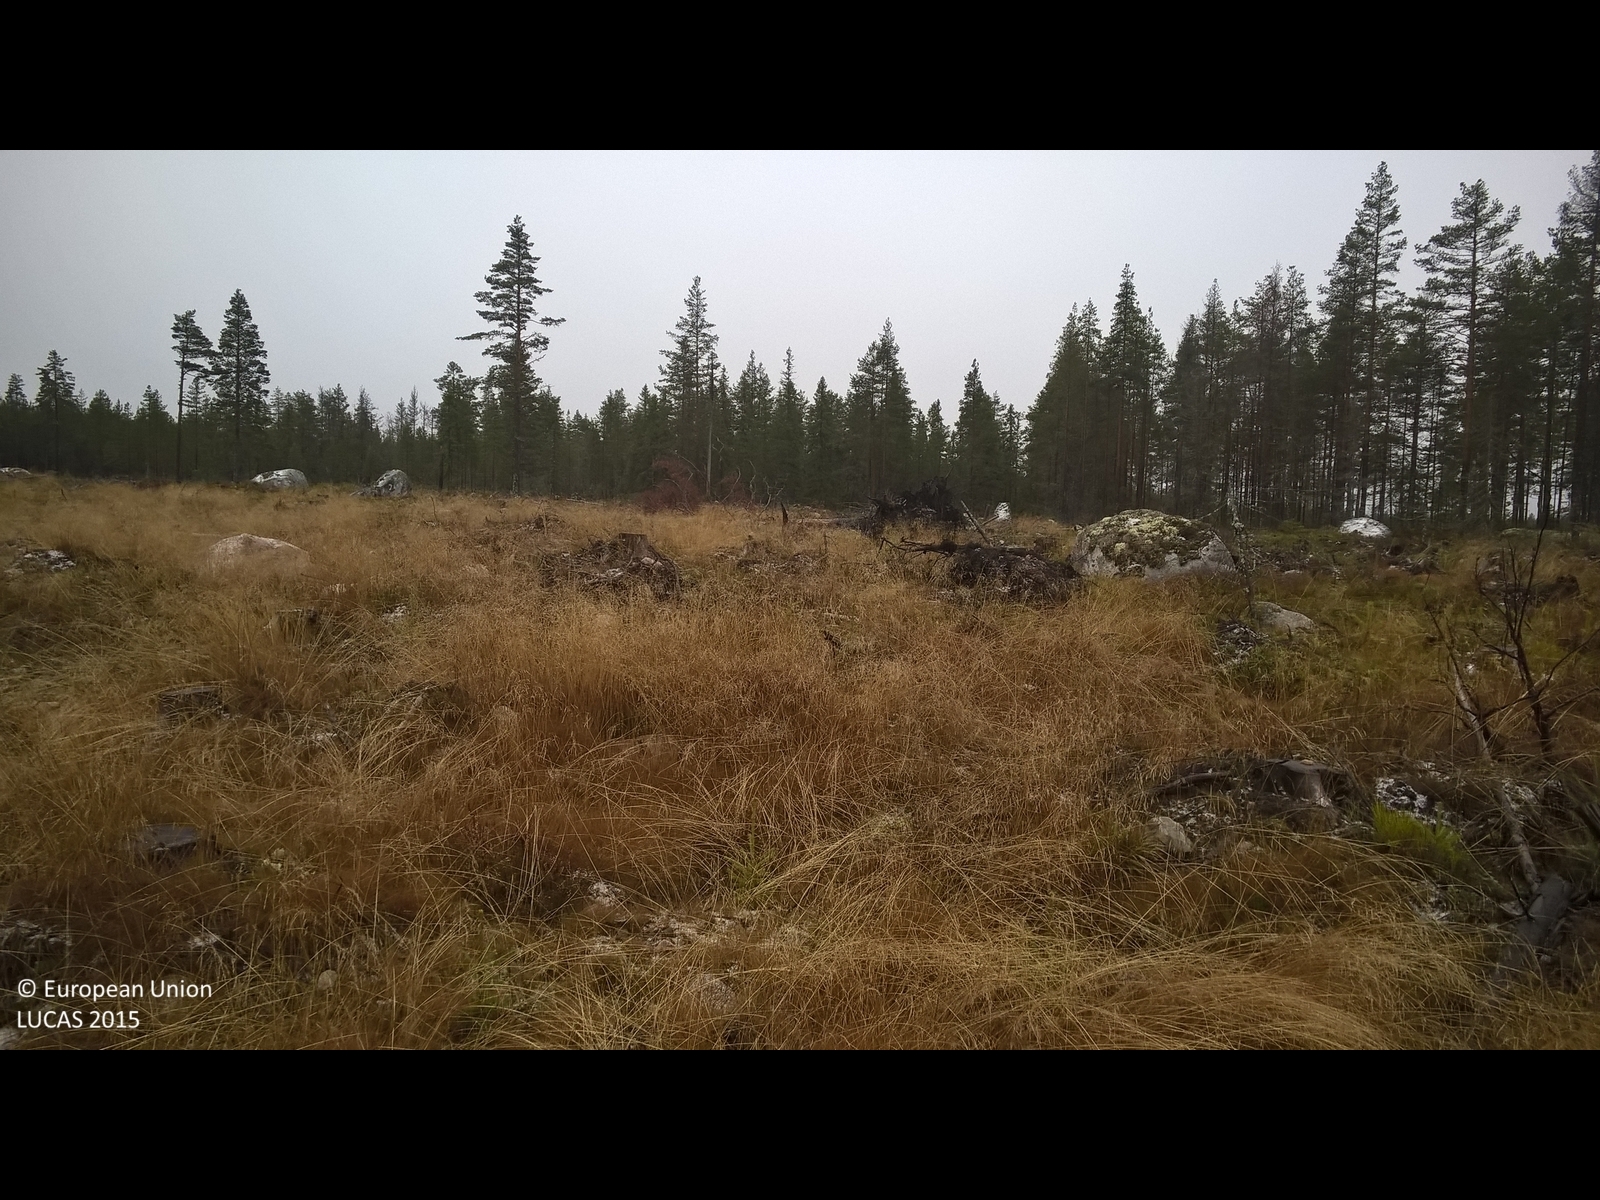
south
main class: Grassland
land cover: Grassland with sparse tree/shrub cover
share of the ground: > 75 %
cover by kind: herbaceous plants 75 %, shrubs 10 %, lichens and mosses 10 %, coniferous forest trees 5 %
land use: Forestry
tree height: < 5 m
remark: Clear cut
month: November
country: SE
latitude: 60.4404
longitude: 14.8400
